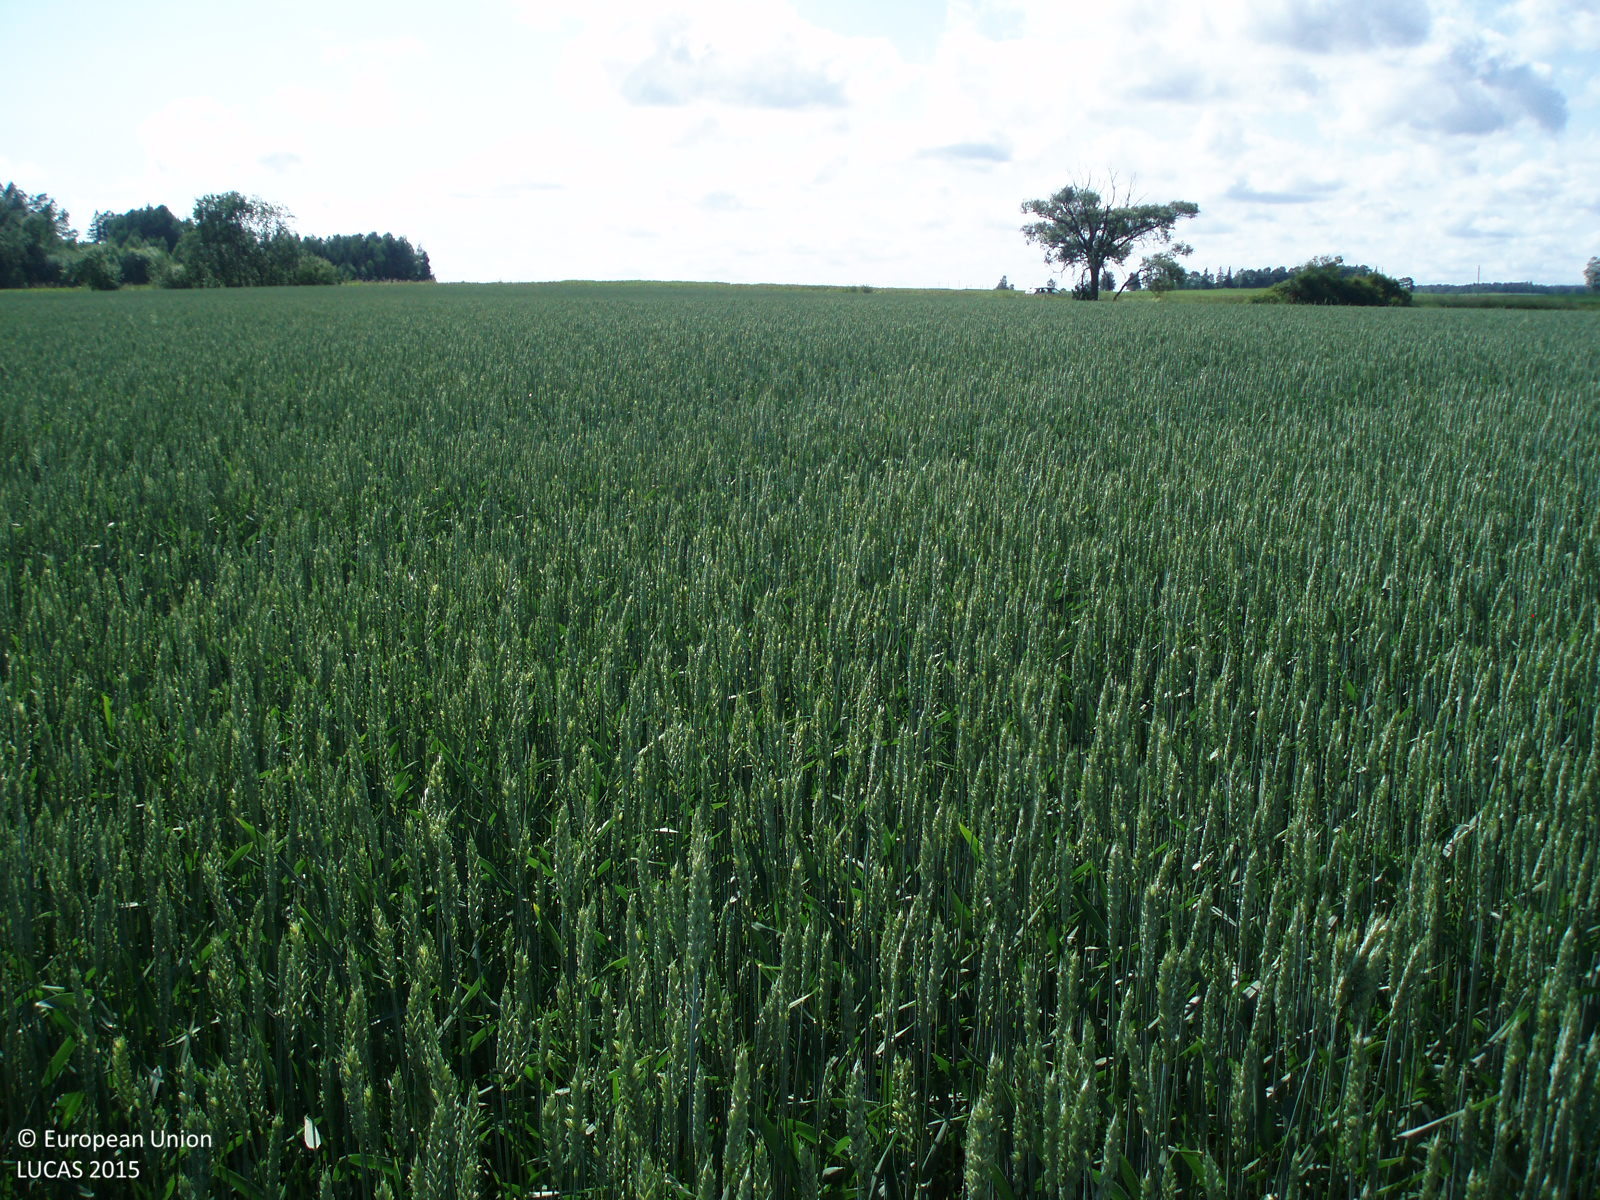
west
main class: Cropland
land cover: Common wheat
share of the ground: > 75 %
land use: Agriculture (excluding fallow land and kitchen gardens)
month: July
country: LT
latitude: 56.0003
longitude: 22.4208
